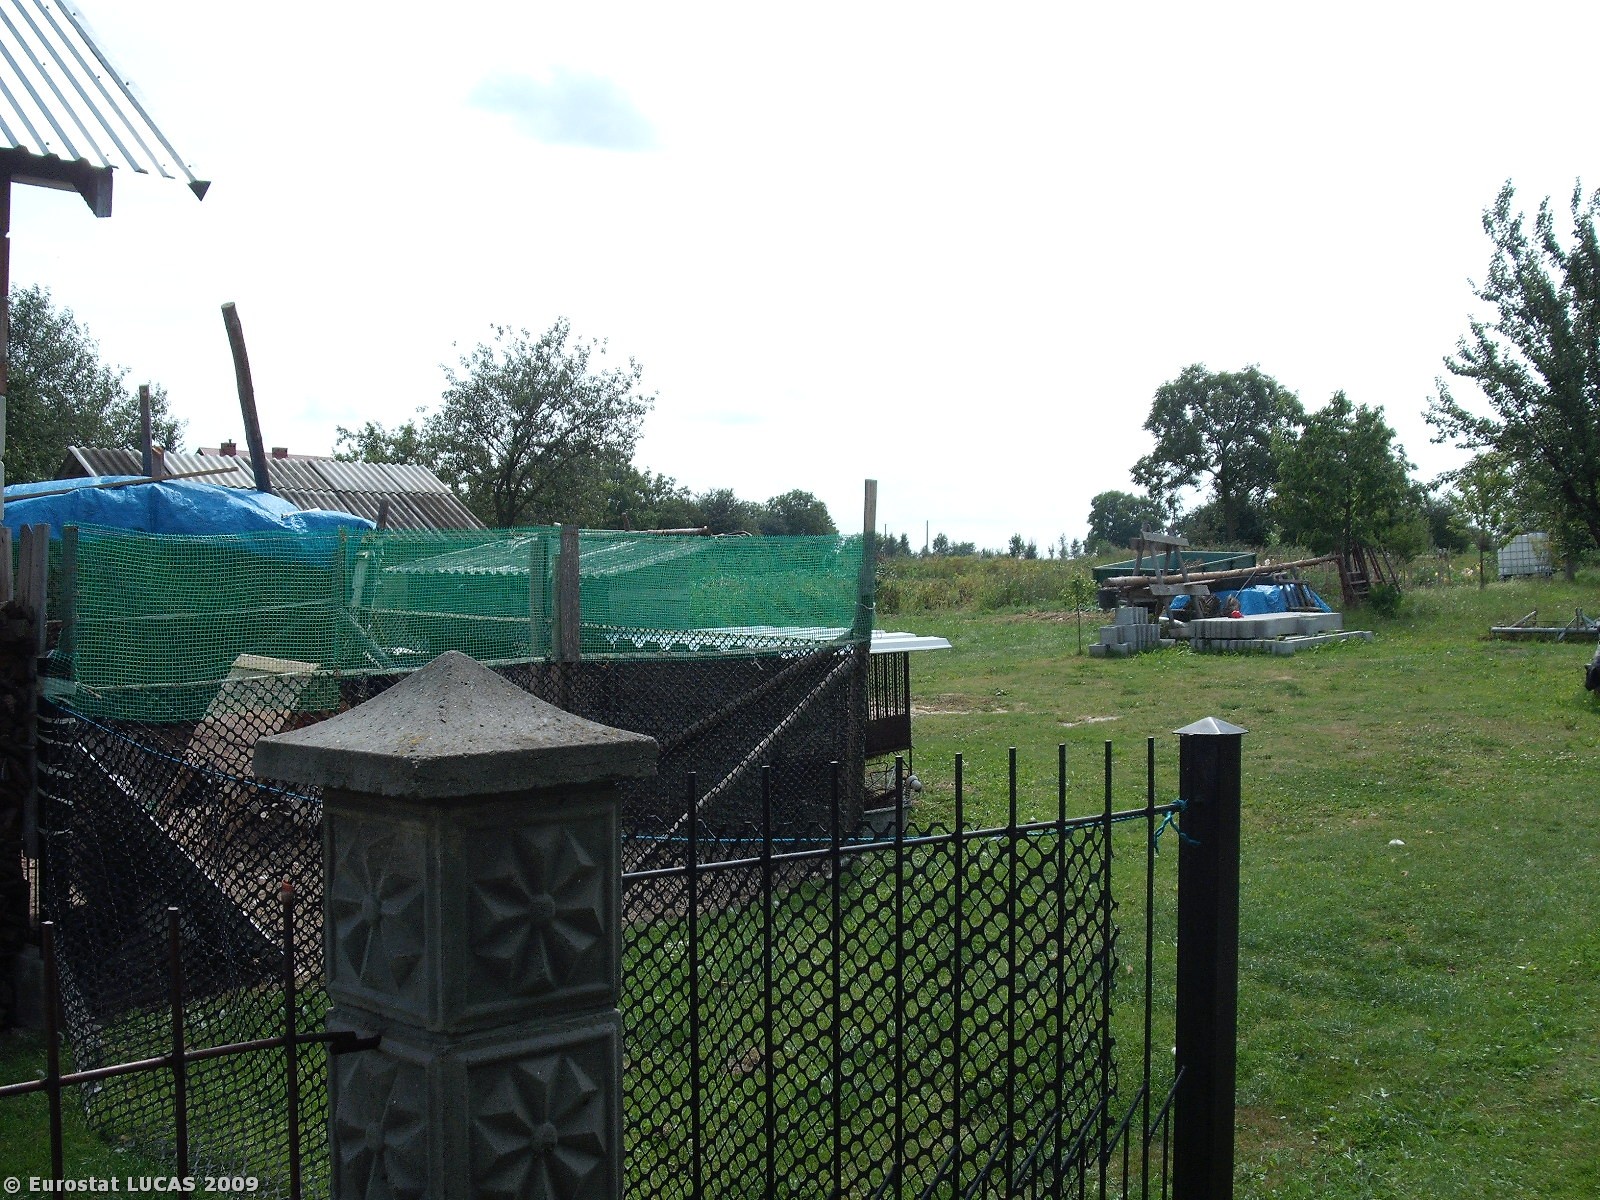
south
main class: Grassland
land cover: Grassland without tree/shrub cover
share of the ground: > 75 %
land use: Residential
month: August
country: PL
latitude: 50.0713
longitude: 22.3725
